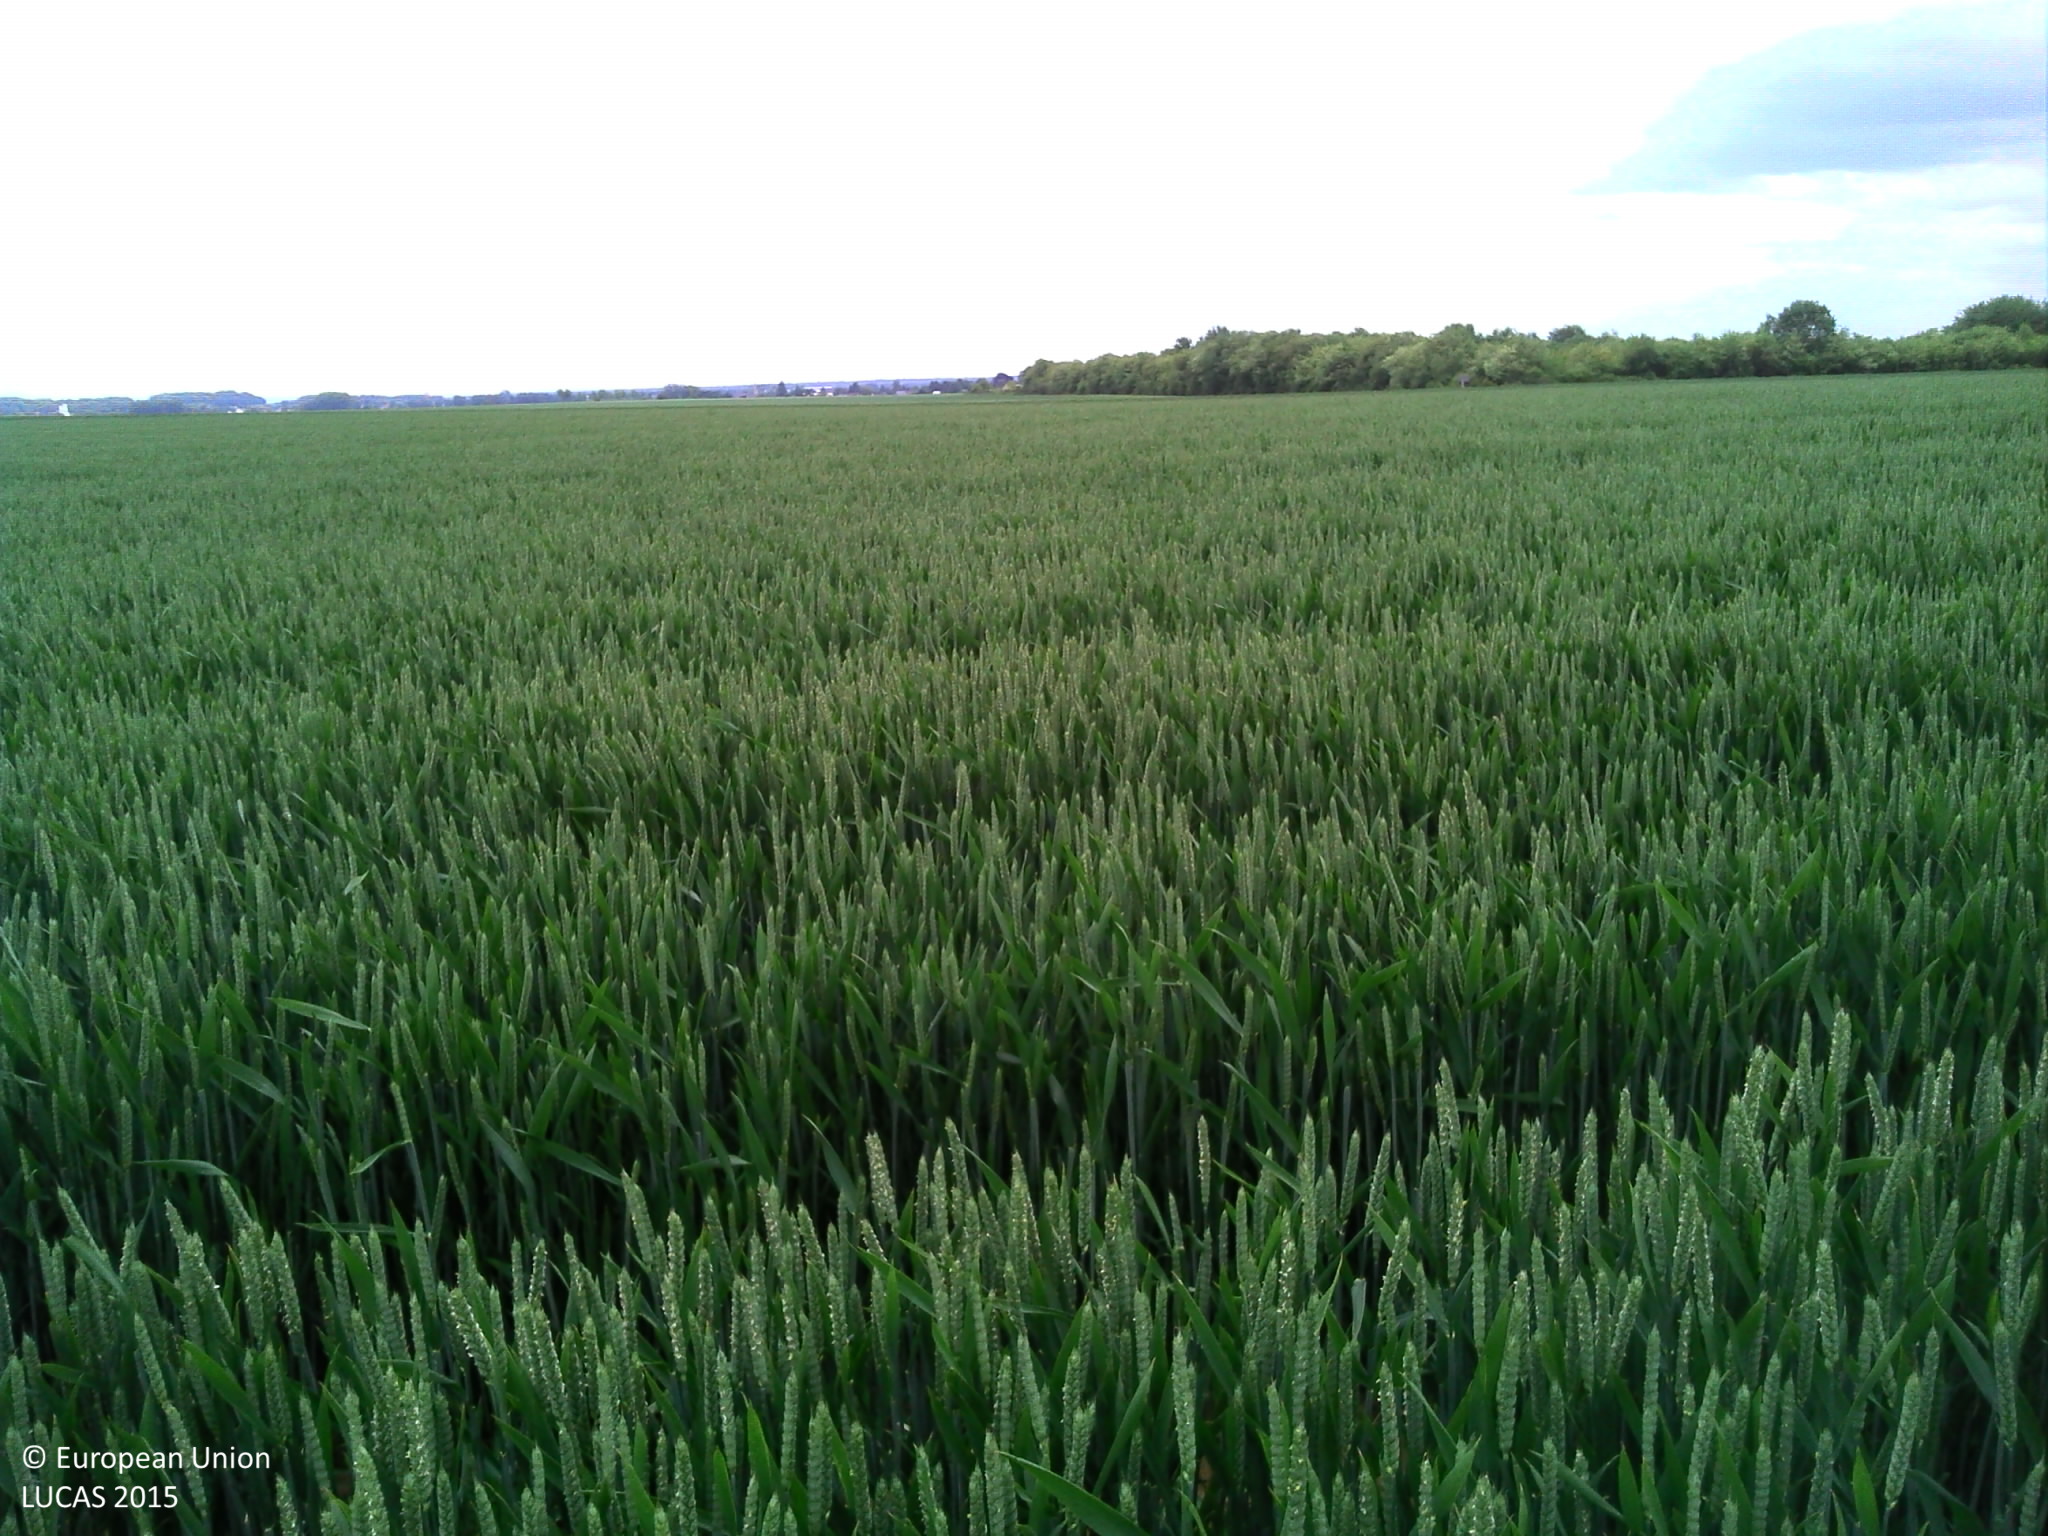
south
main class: Cropland
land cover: Common wheat
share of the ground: > 75 %
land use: Agriculture (excluding fallow land and kitchen gardens)
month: May
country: FR
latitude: 49.7664
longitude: 3.2301
